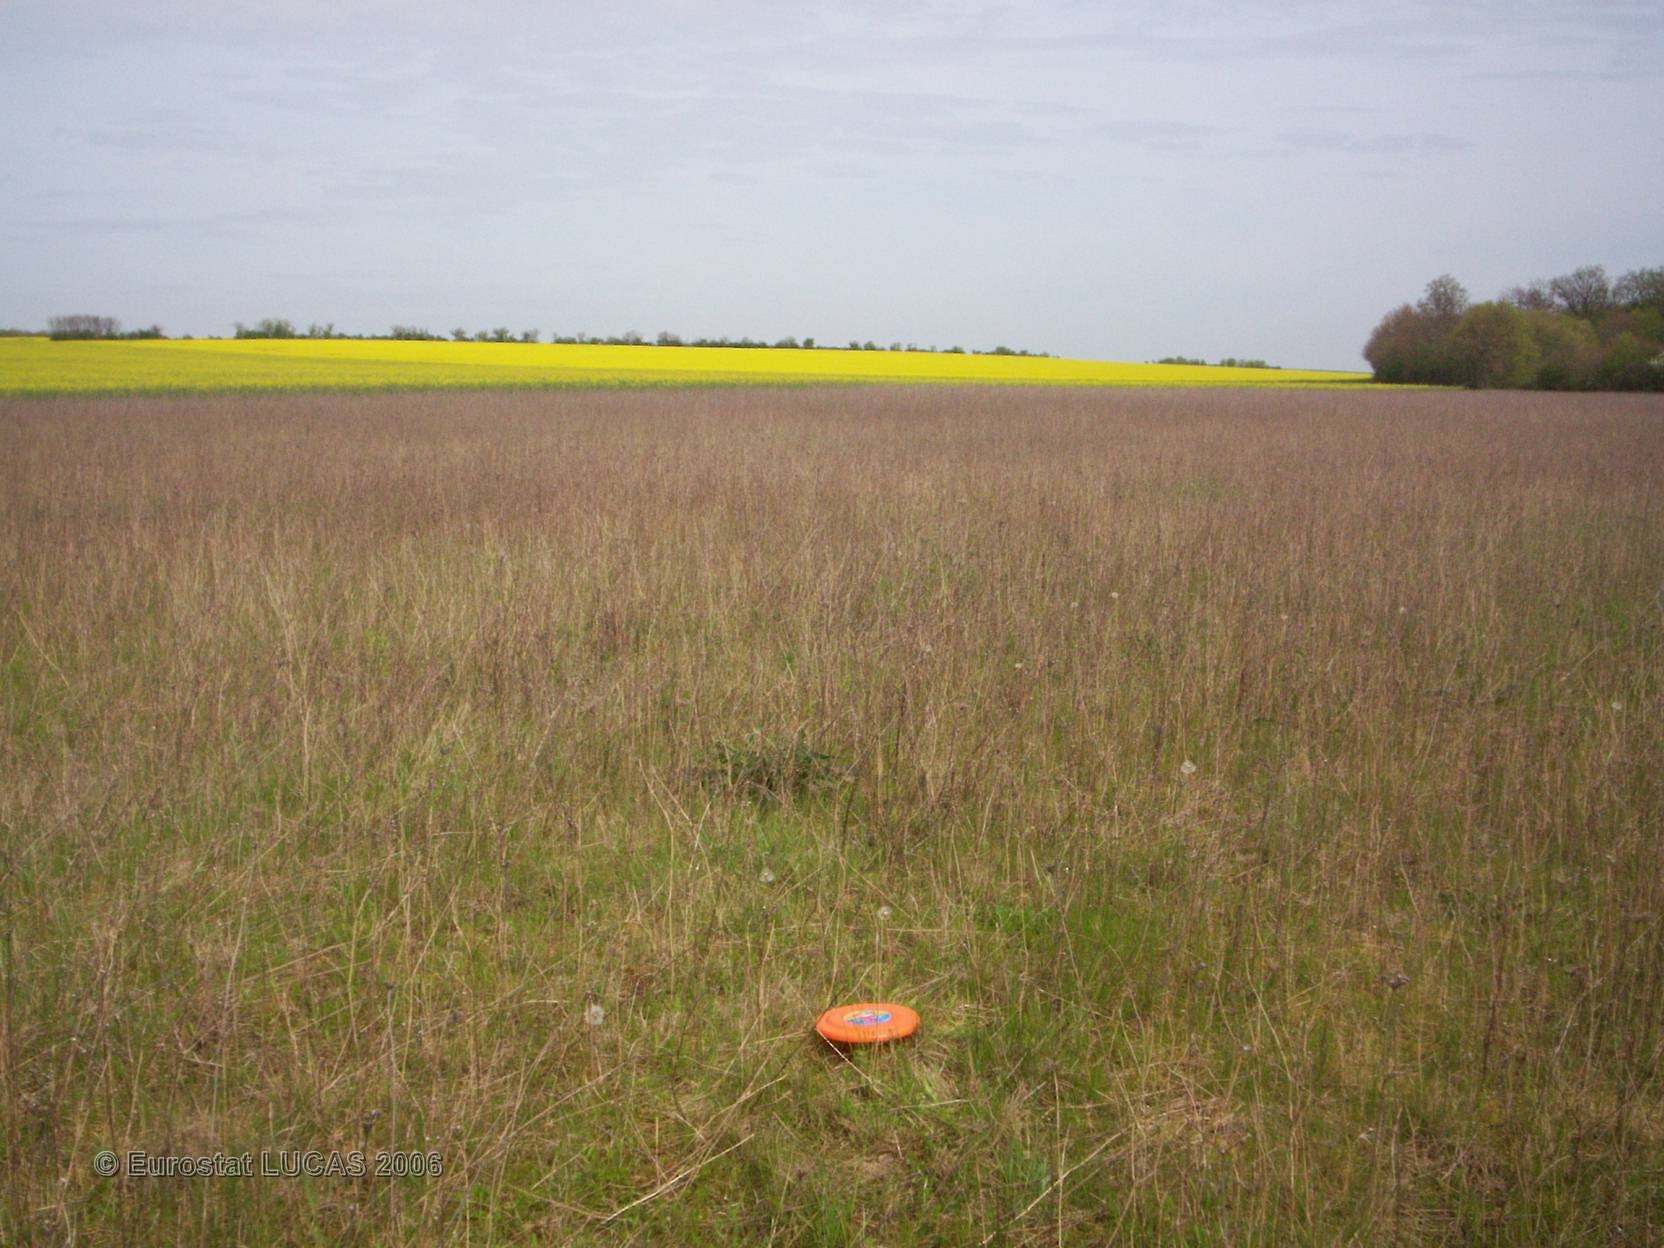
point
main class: Grassland
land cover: Grassland without tree/shrub cover
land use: Fallow land
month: May
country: FR
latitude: 47.2835
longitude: 3.0806
